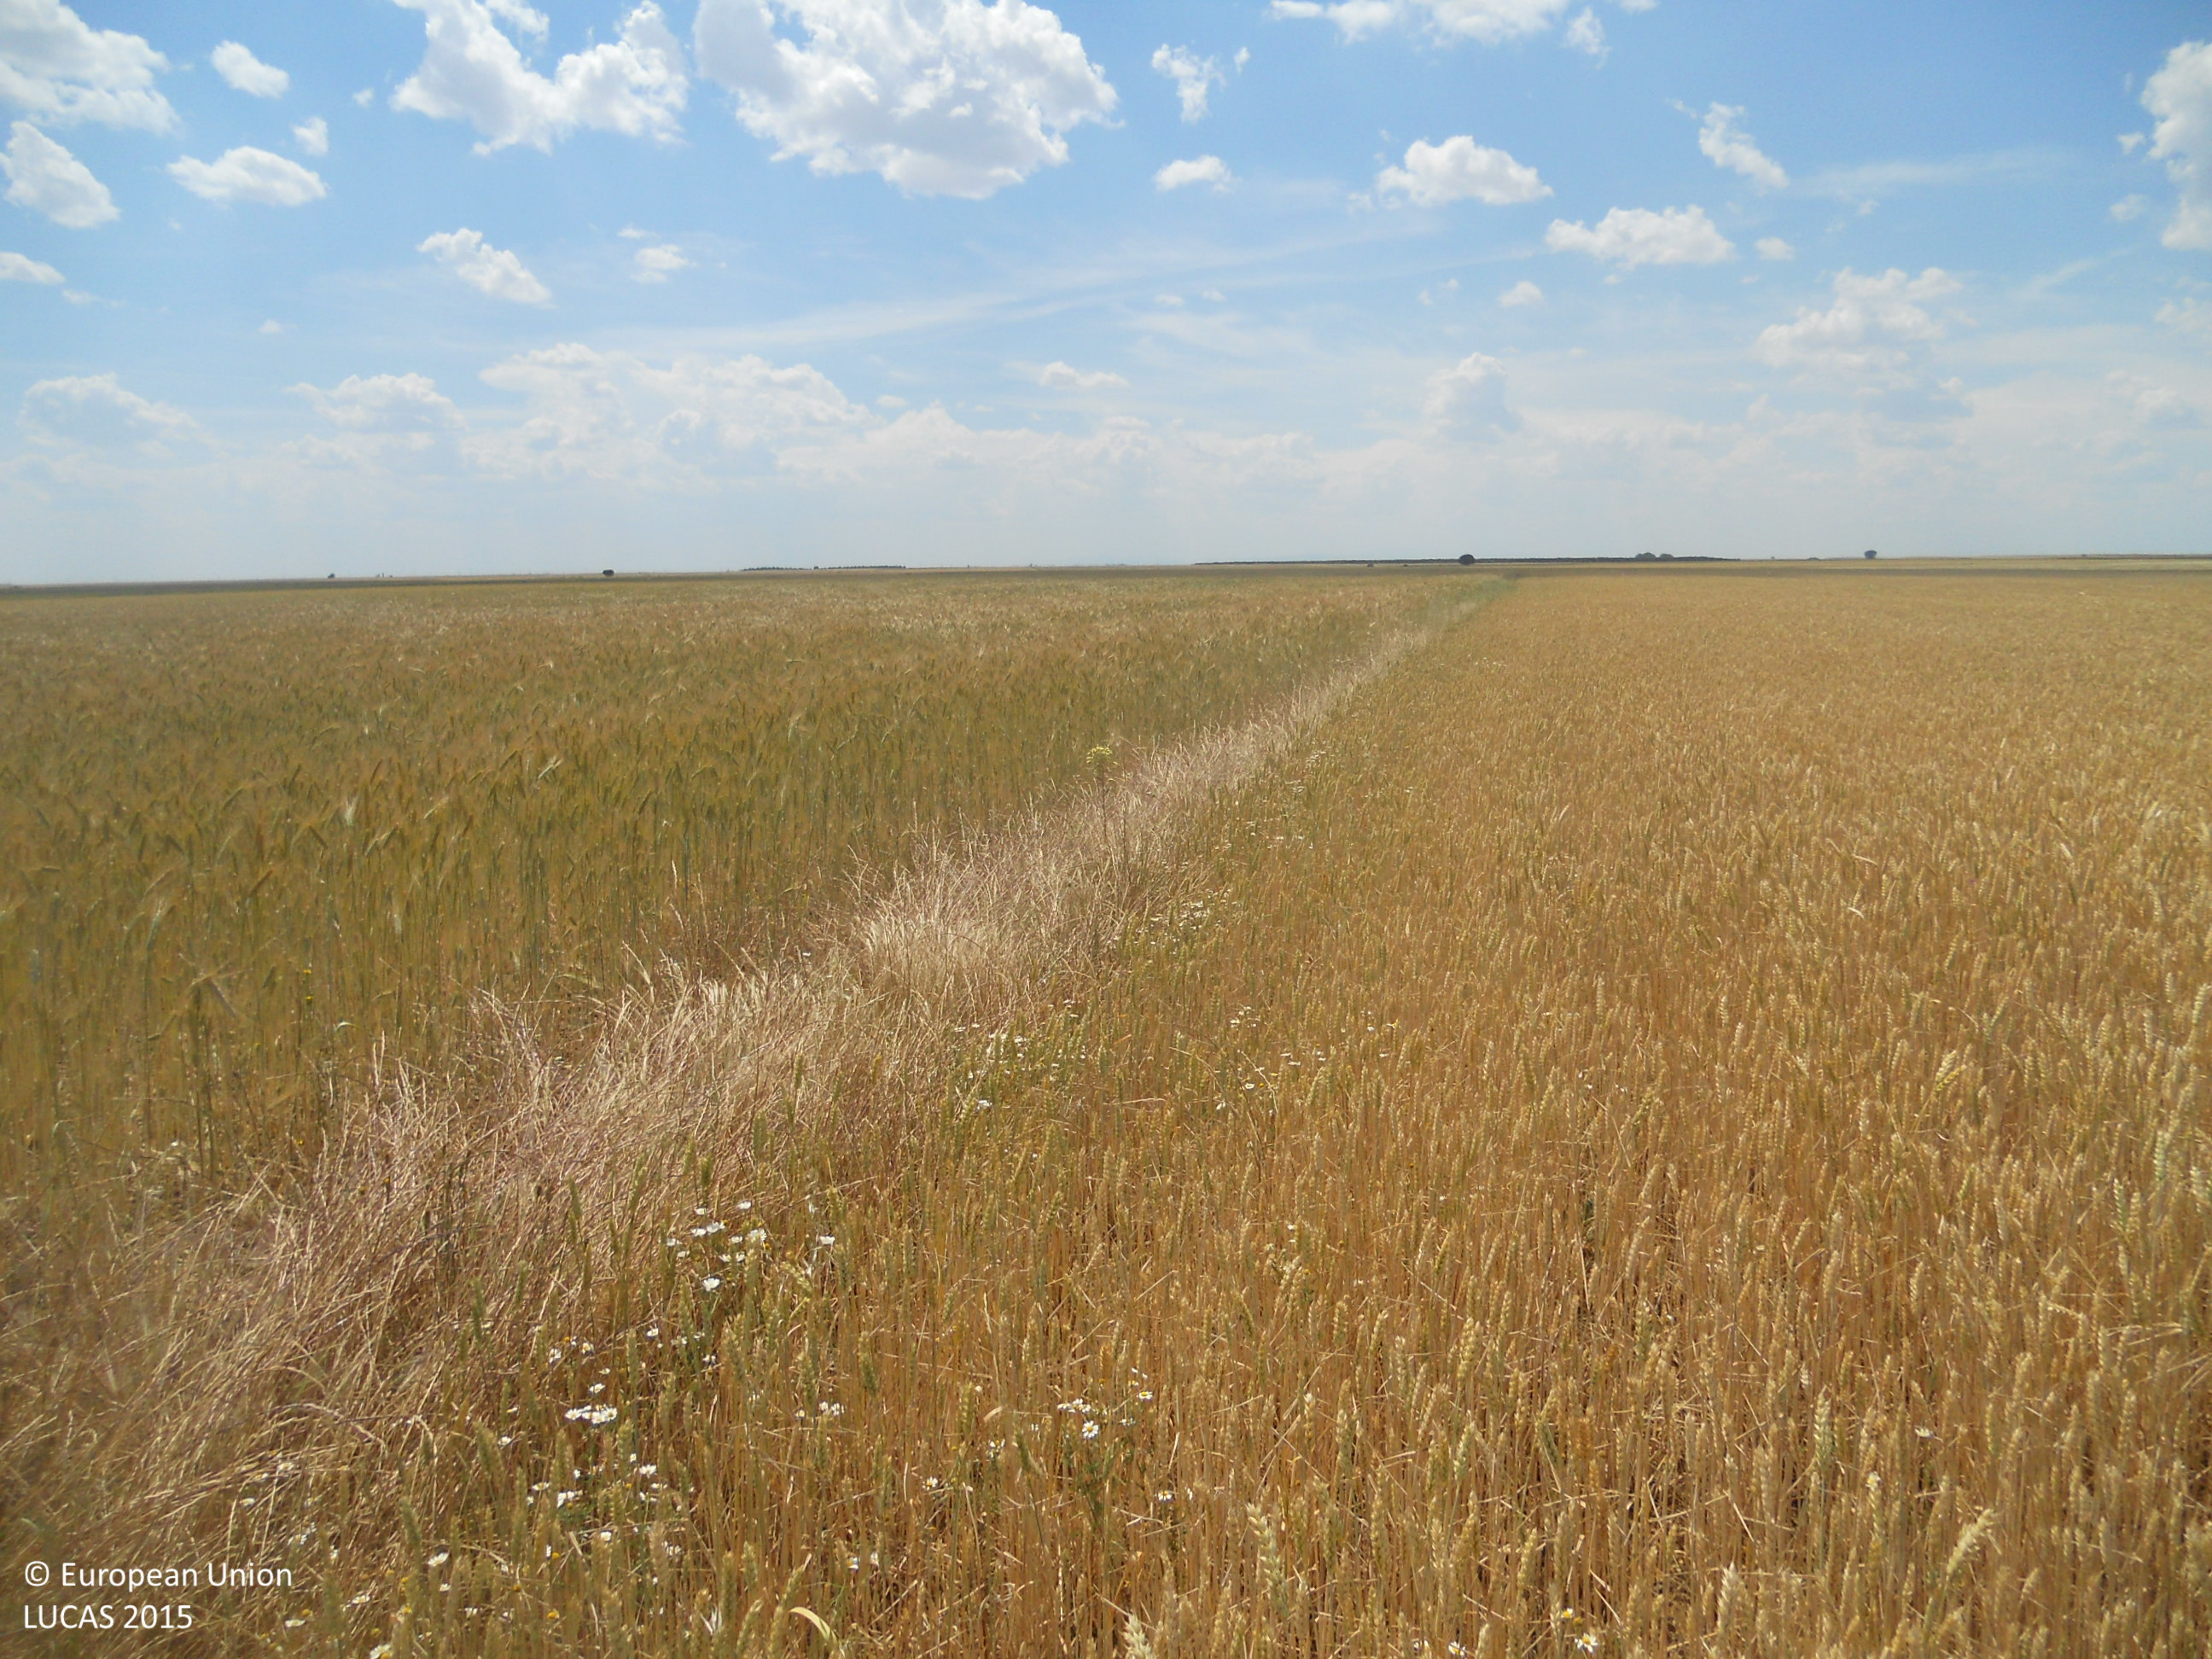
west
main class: Cropland
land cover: Common wheat
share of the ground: > 75 %
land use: Agriculture (excluding fallow land and kitchen gardens)
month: June
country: ES
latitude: 42.2823
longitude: -5.3562
